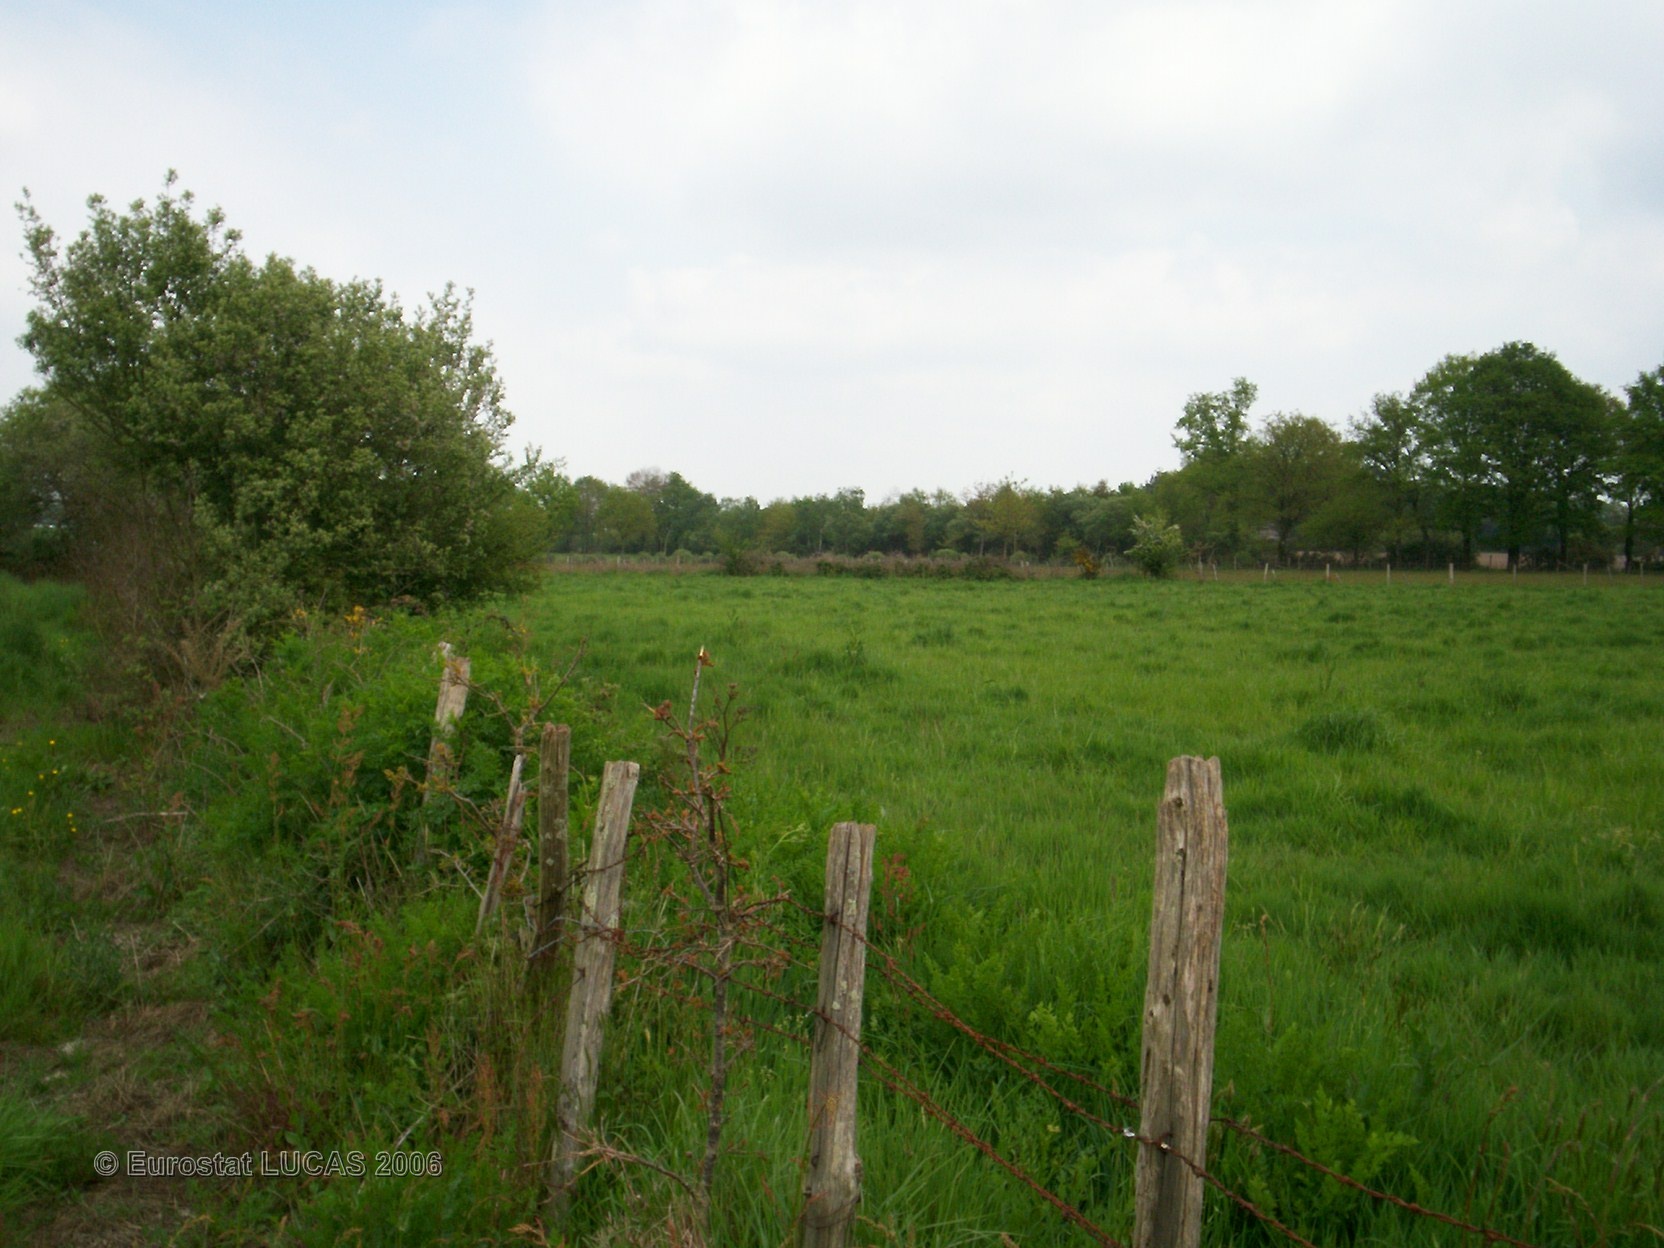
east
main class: Grassland
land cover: Grassland without tree/shrub cover
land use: Agriculture (excluding fallow land and kitchen gardens)
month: May
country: FR
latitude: 47.5213
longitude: -2.2313
